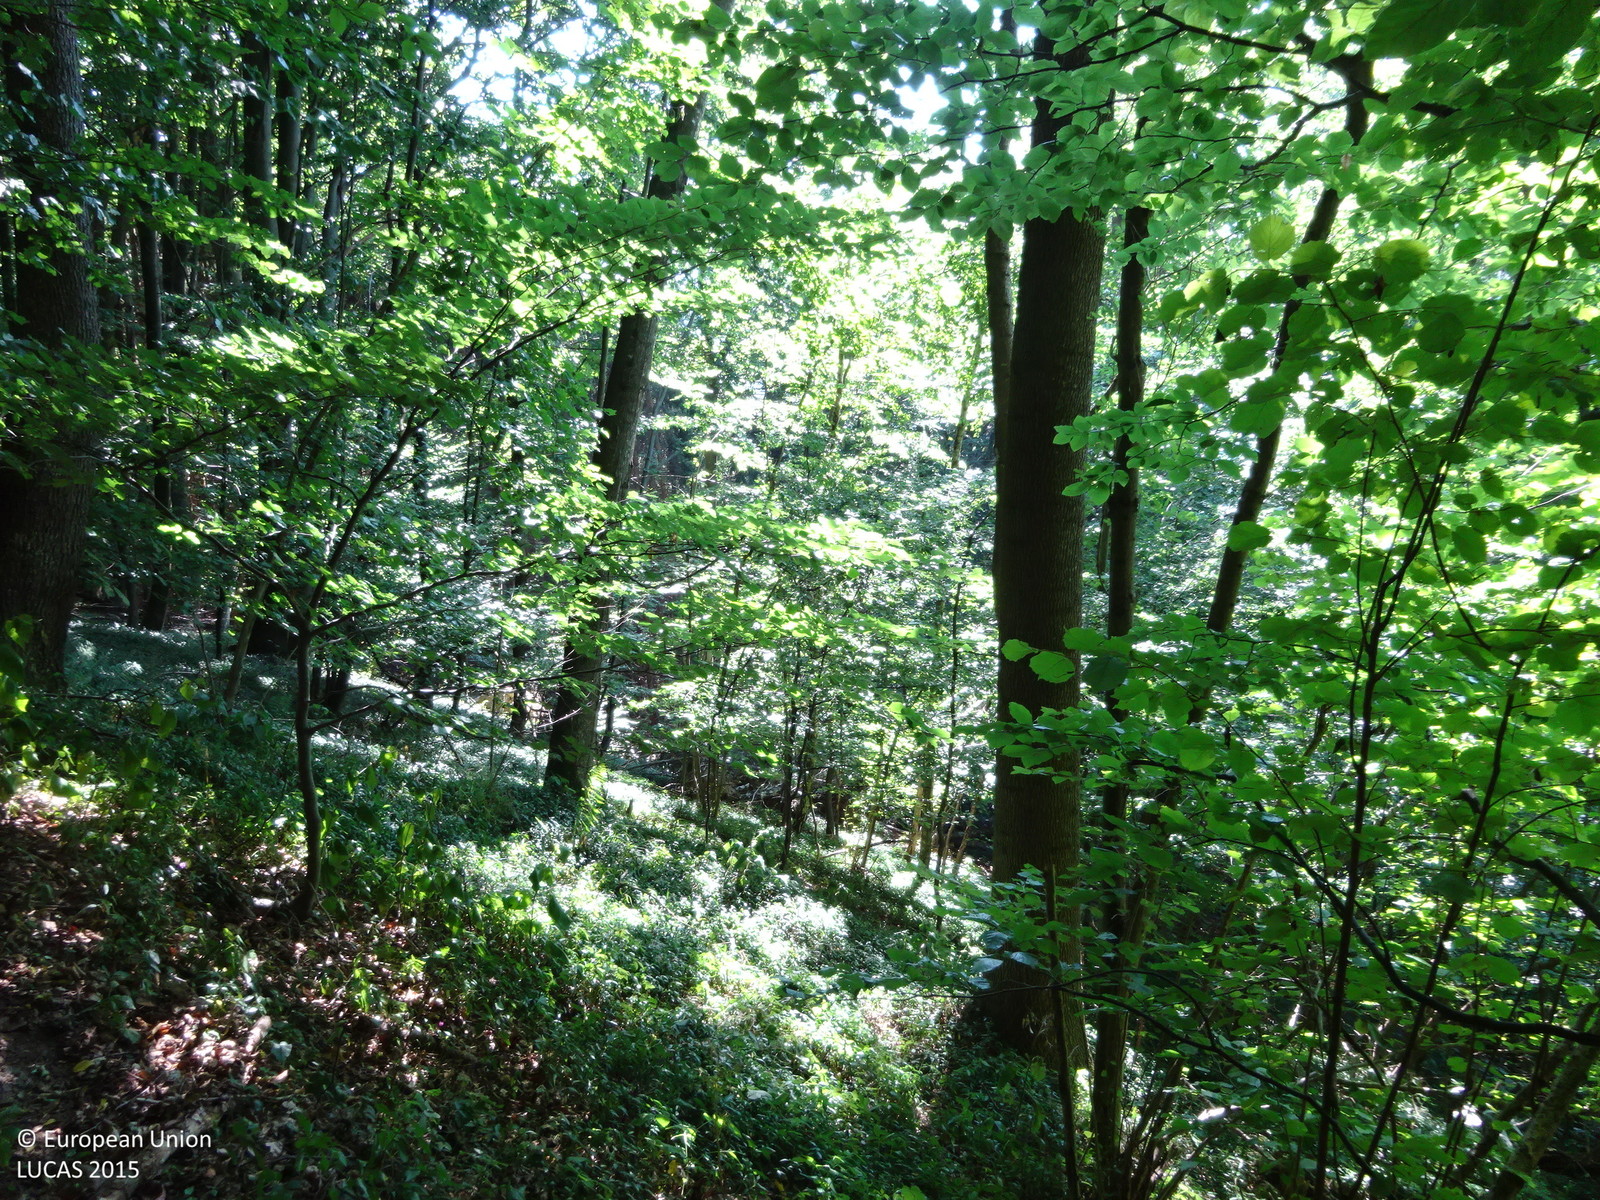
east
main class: Woodland
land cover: Broadleaved woodland
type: beech forest
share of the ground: > 75 %
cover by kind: broadleaved forest trees 100 %
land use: Forestry
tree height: > 5 m
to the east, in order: Broadleaved woodland; Spruce dominated coniferous woodland; Spruce dominated mixed woodland; Tracks; Spontaneously vegetated surfaces; Tracks; Spruce dominated mixed woodland; Broadleaved woodland; Spruce dominated mixed woodland
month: August
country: AT
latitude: 47.4401
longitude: 16.1153
